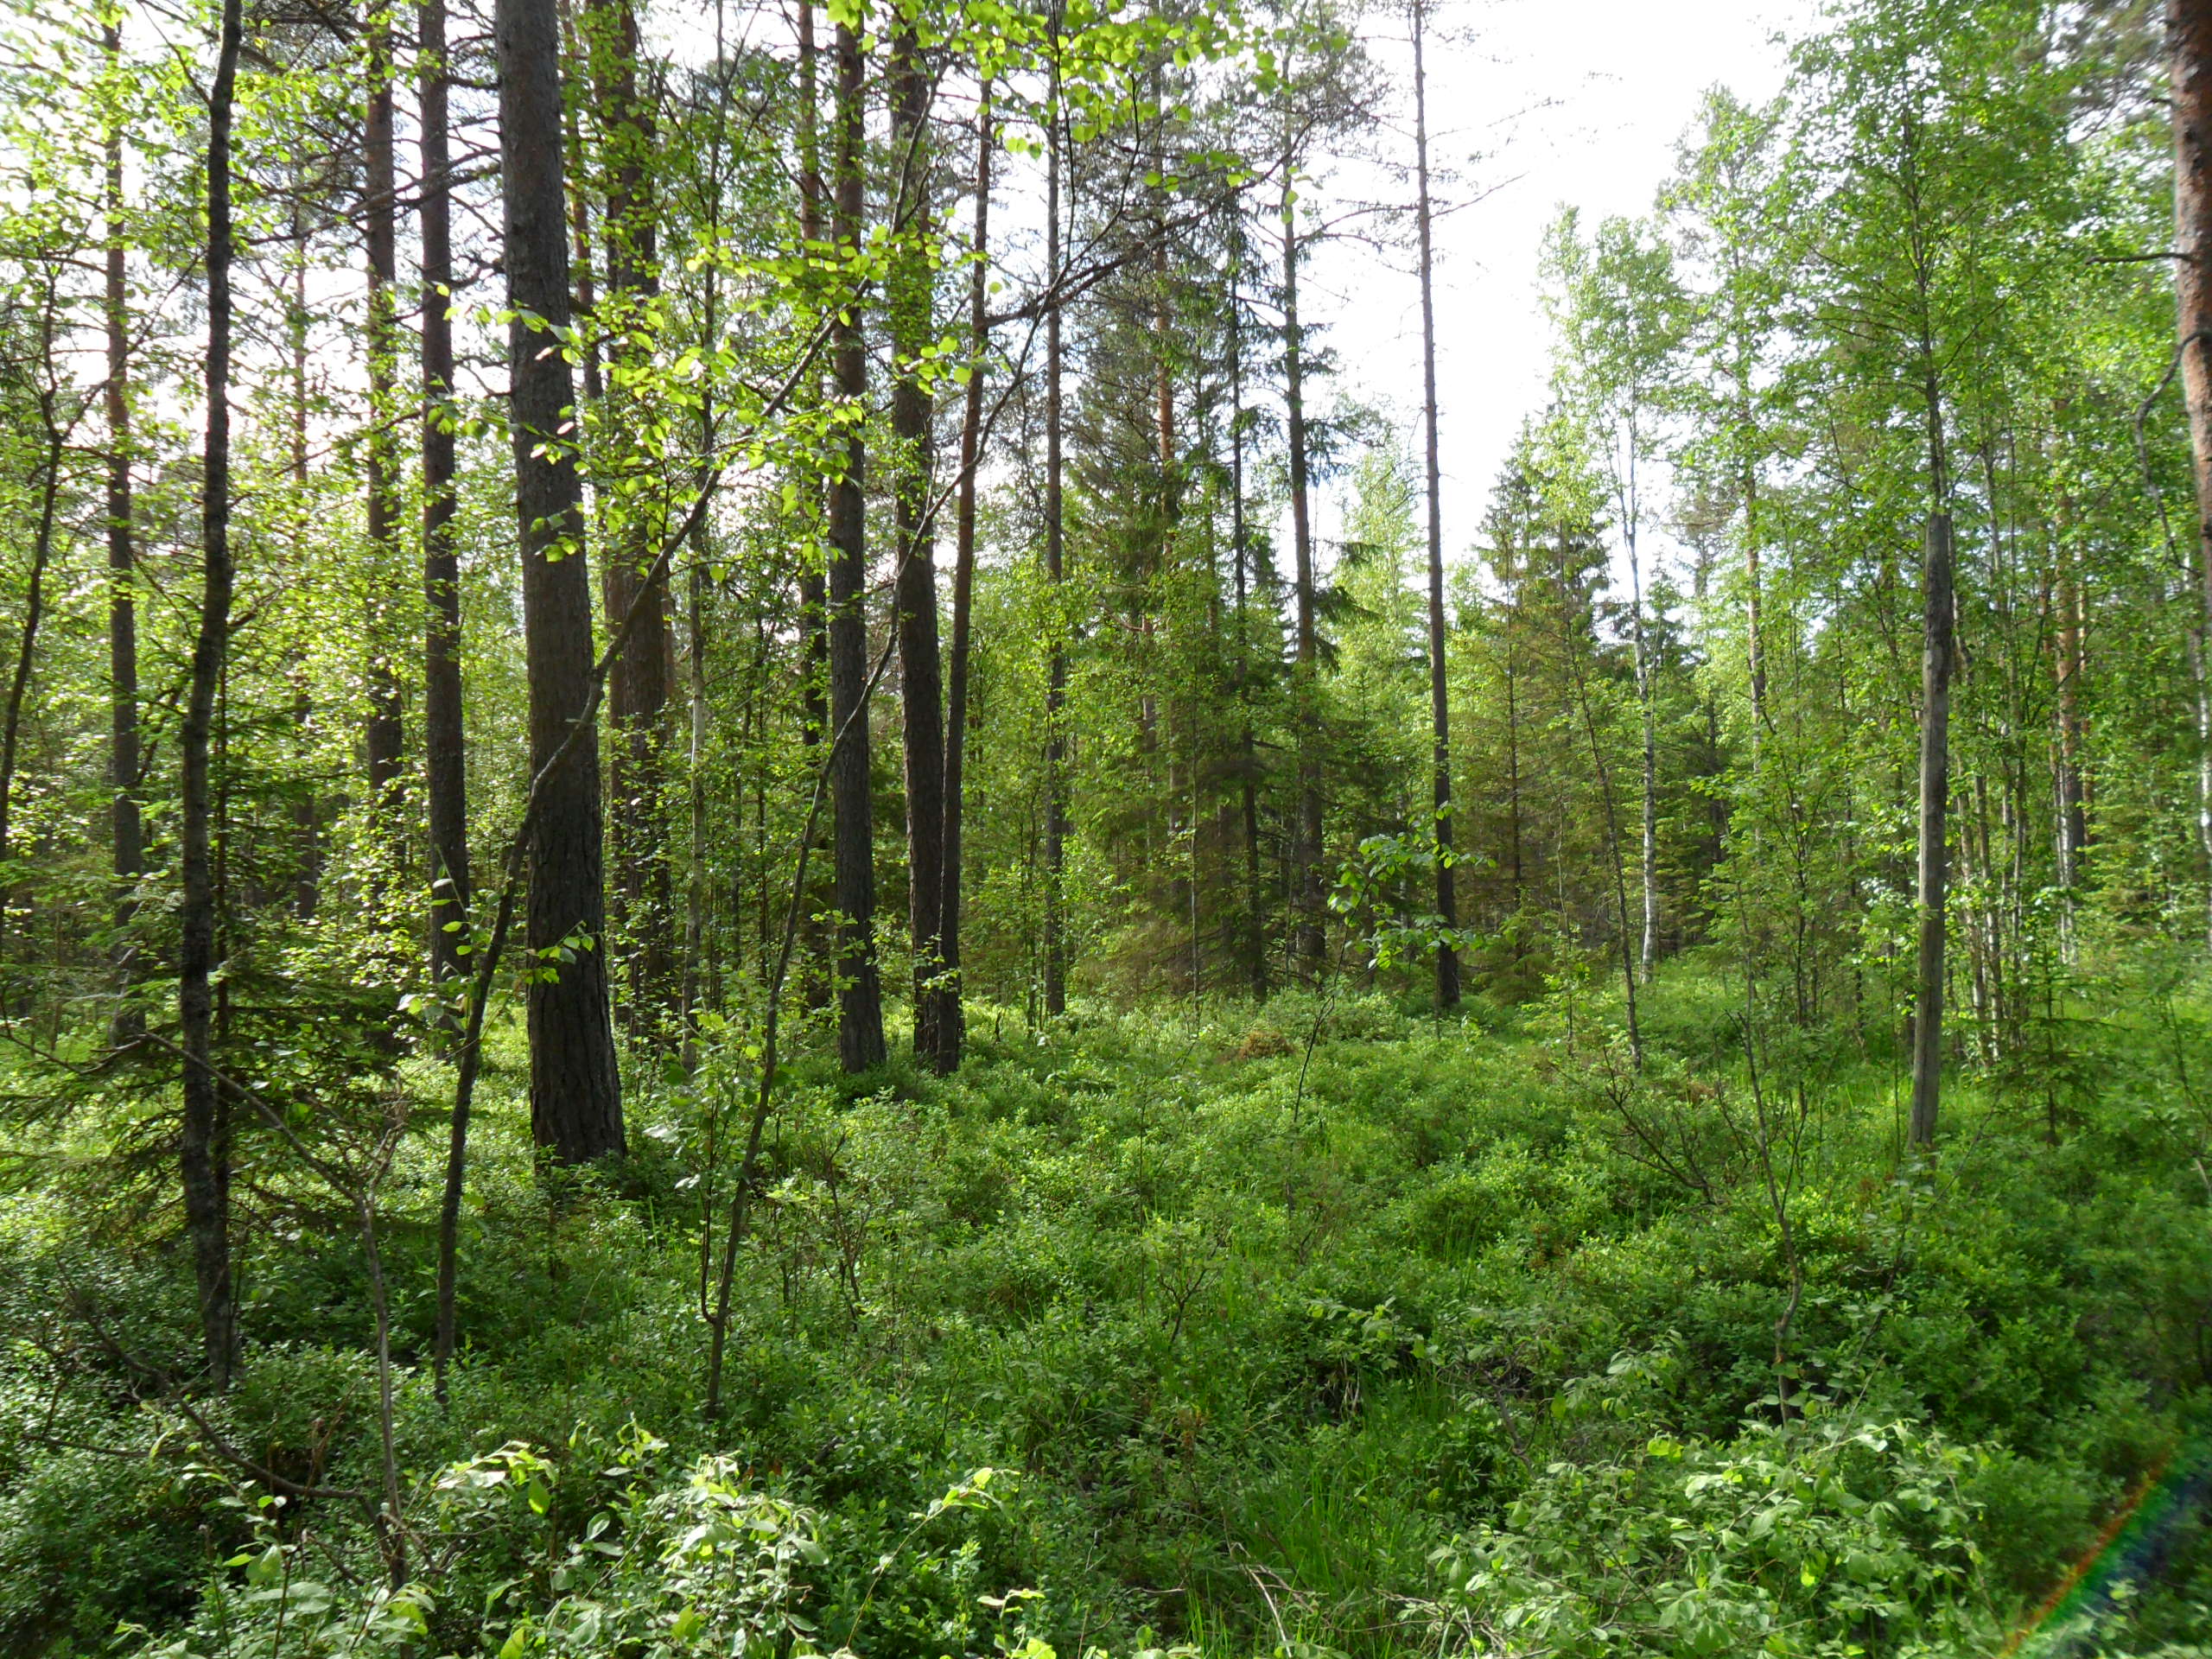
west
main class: Woodland
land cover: Pine dominated mixed woodland
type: hemiboreal forest and nemoral coniferous forest and mixed broadleaved-coniferous forest
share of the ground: 50 - 75 %
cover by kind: coniferous forest trees 45 %, broadleaved forest trees 25 %, herbaceous plants 15 %, lichens and mosses 10 %, shrubs 5 %
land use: Forestry
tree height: > 5 m
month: June
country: LV
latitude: 57.5918
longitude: 22.5498
